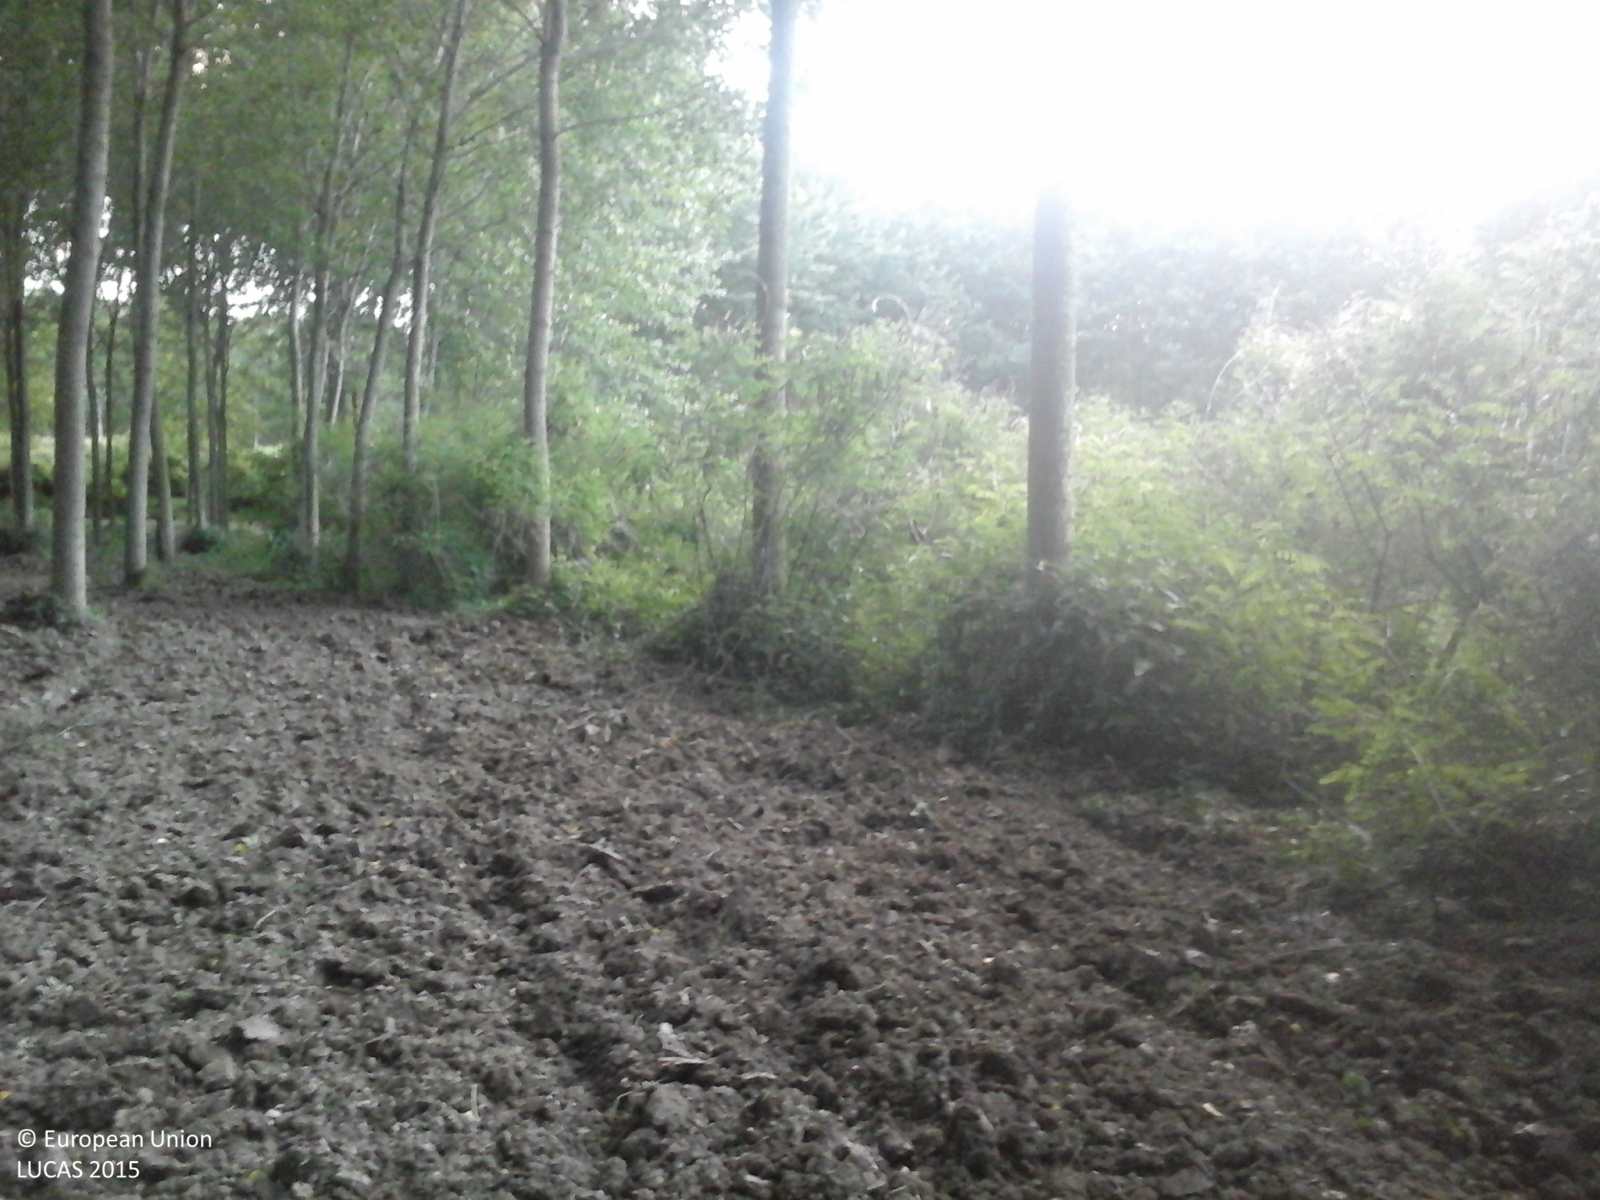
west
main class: Woodland
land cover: Broadleaved woodland
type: non-riverine alder, birch or aspen forest
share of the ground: > 75 %
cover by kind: broadleaved forest trees 100 %
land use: Forestry
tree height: > 5 m
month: May
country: IT
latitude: 45.0680
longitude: 10.9000
